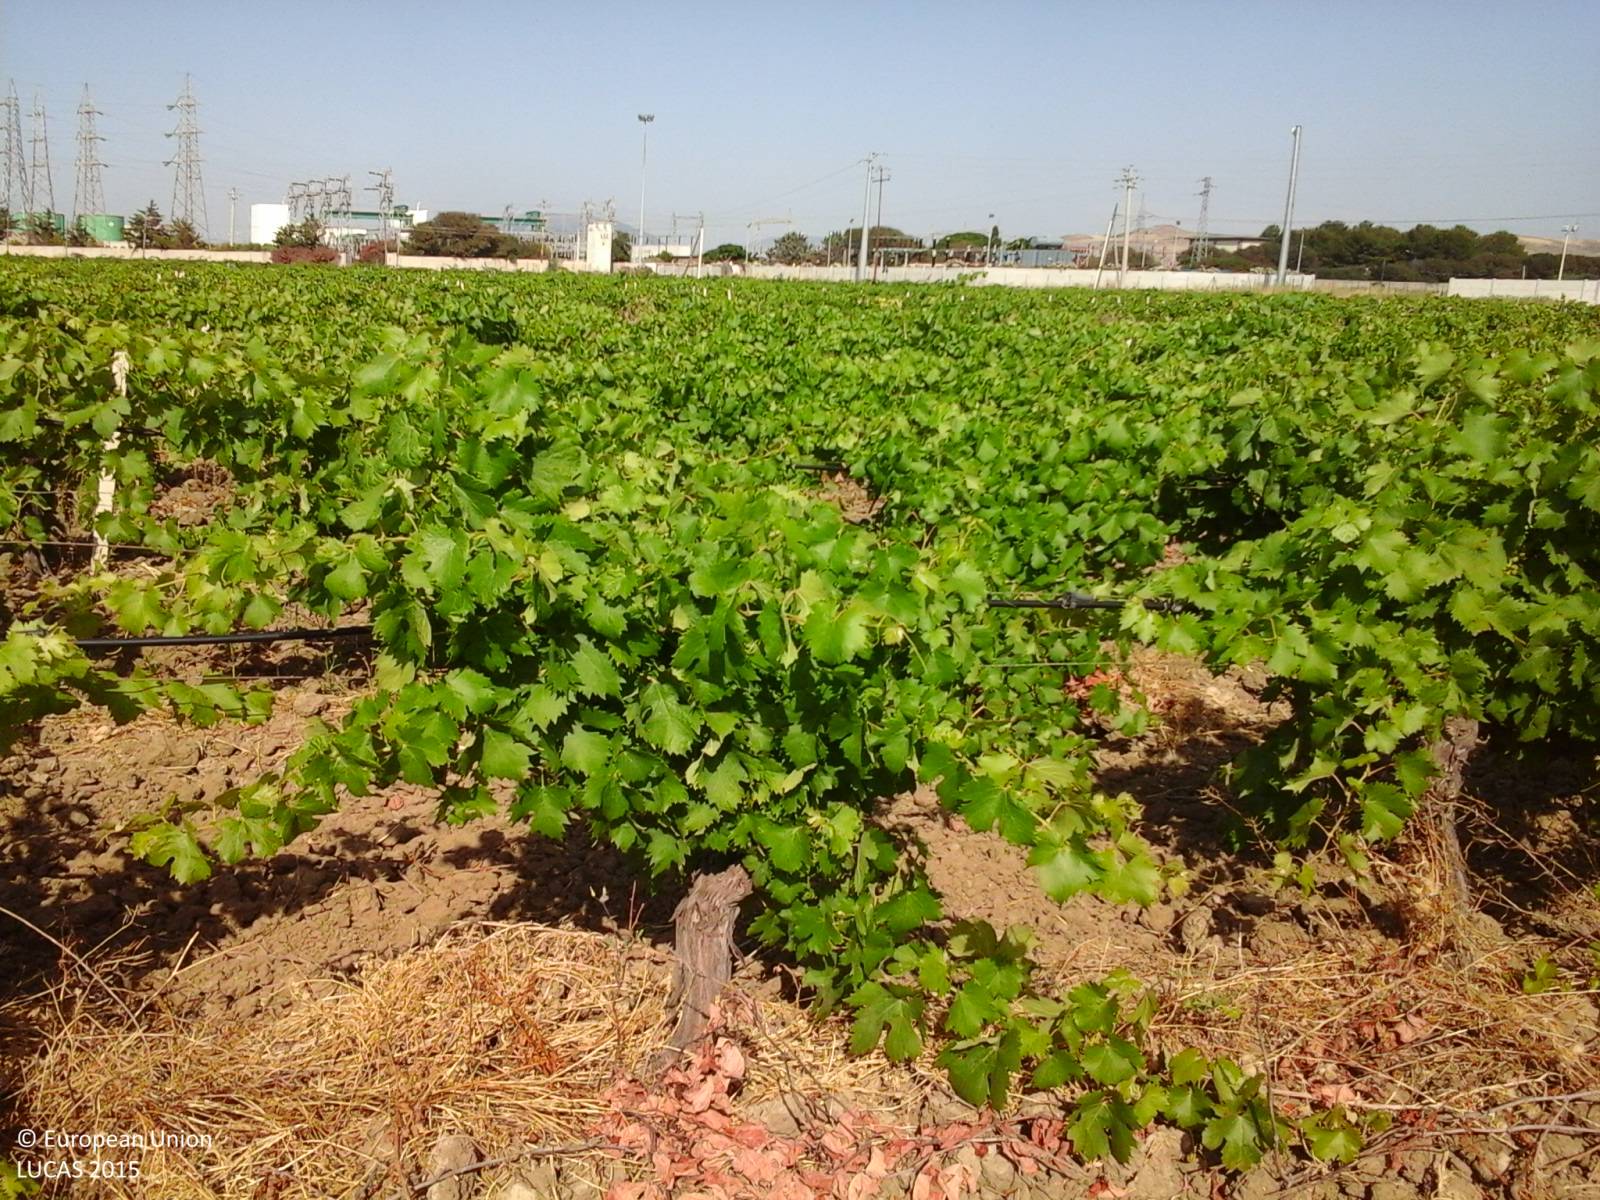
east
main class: Cropland
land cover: Vineyards
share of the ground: 50 - 75 %
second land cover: Other bare soil
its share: > 75 %
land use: Agriculture (excluding fallow land and kitchen gardens)
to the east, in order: Vineyards; Other bare soil; Spontaneously vegetated surfaces; Vineyards; Electric lines; Vineyards; Durum wheat; Ditches and canals; Grass margins; Tracks; Grass margins; Paved roads, cycling and walking lanes; Grassland without tree/shrub cover; Fences; Grassland without tree/shrub cover; Electric lines; Grassland without tree/shrub cover; Artificial constructions in urban areas; Broadleaved woodland; Artificial constructions in urban areas
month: June
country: IT
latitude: 37.8759
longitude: 12.5844
